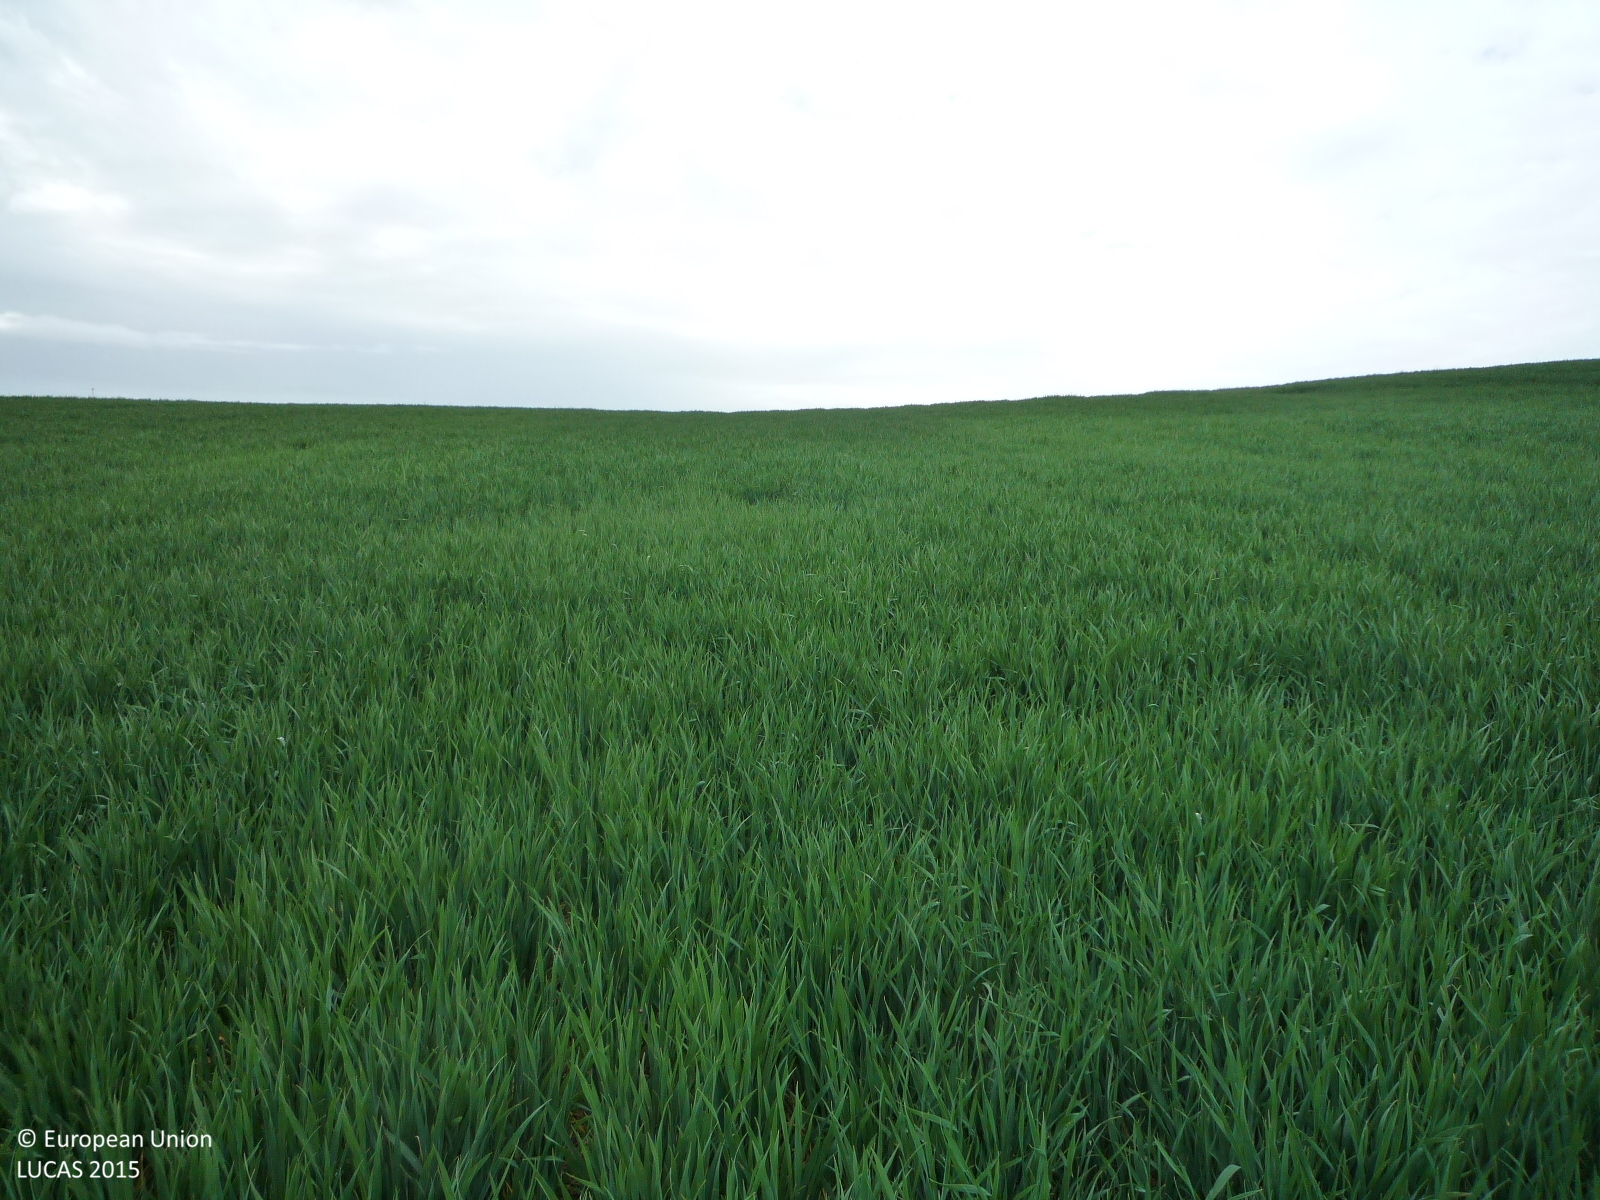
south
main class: Cropland
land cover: Common wheat
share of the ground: > 75 %
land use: Agriculture (excluding fallow land and kitchen gardens)
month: April
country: ES
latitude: 41.9520
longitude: 1.7257
